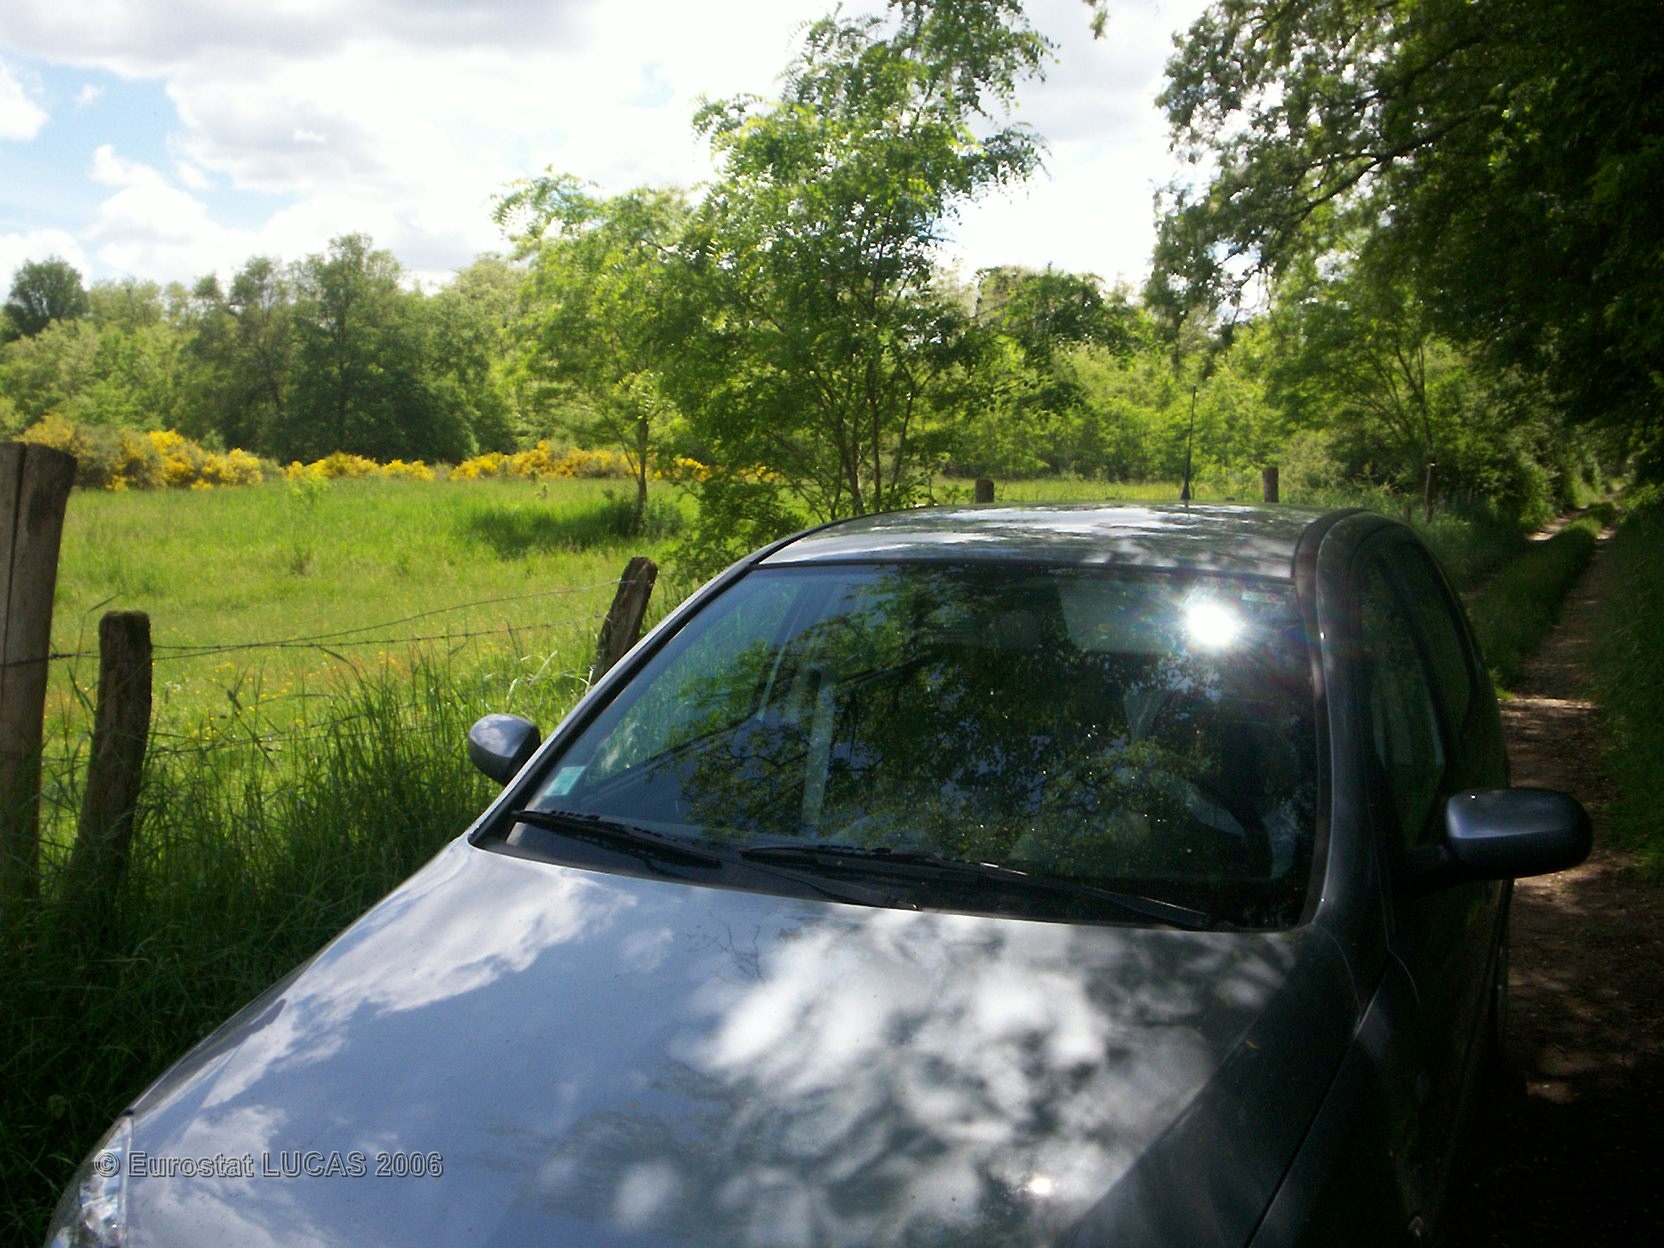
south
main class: Grassland
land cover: Grassland without tree/shrub cover
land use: Agriculture (excluding fallow land and kitchen gardens)
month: May
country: FR
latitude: 47.0473
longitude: 3.0590
